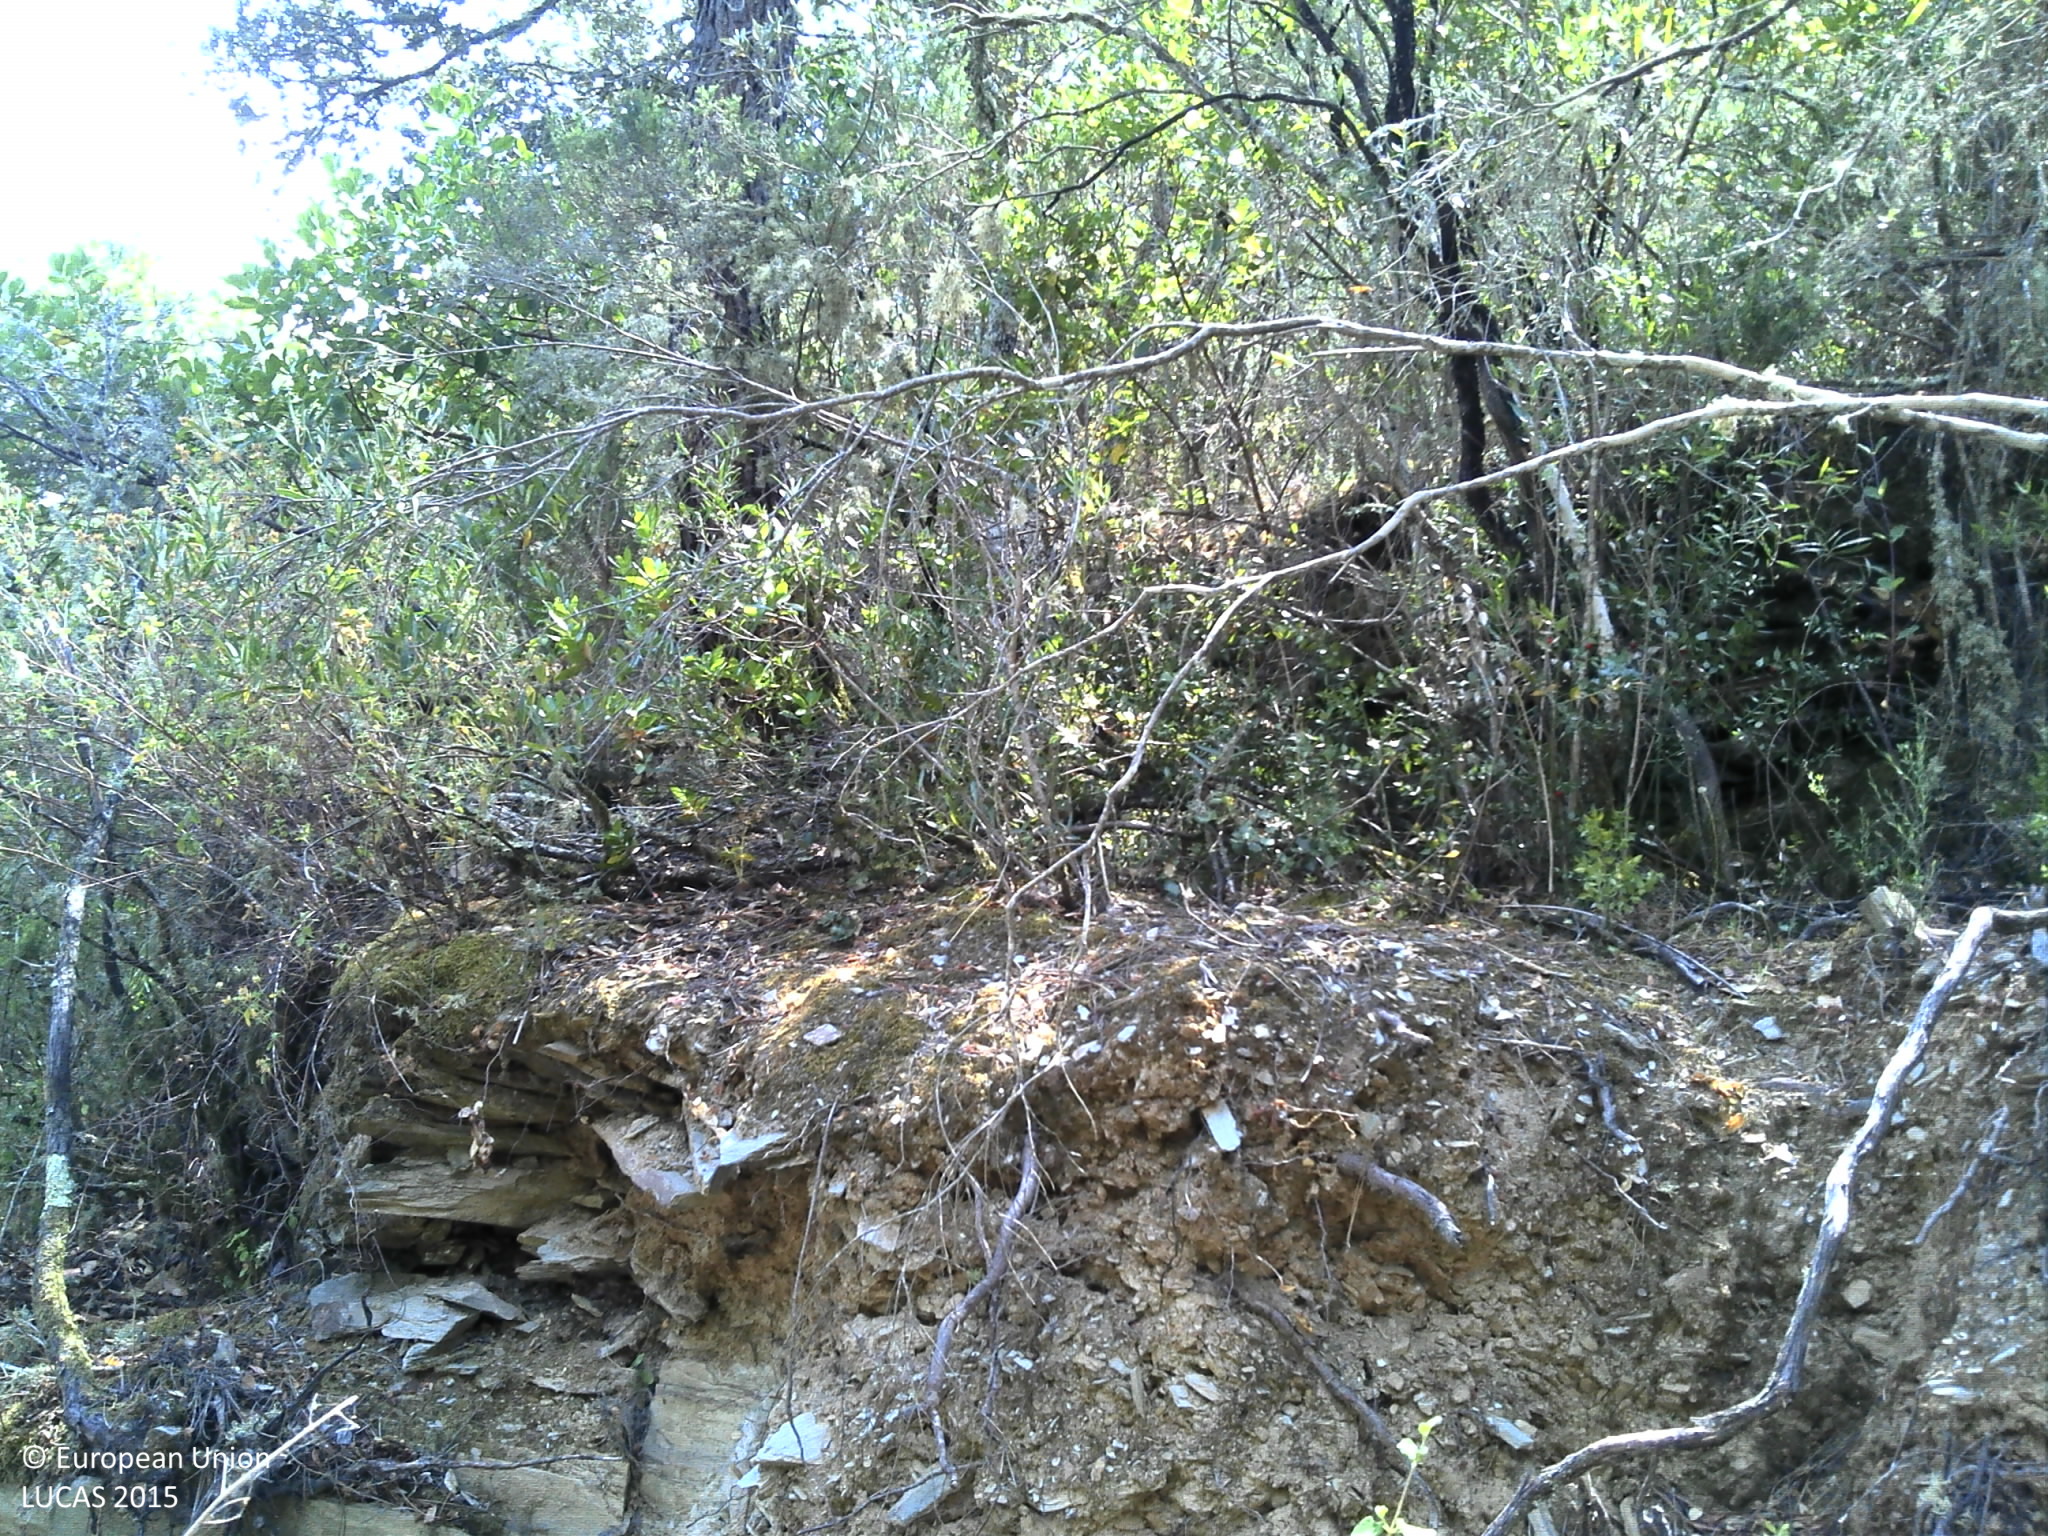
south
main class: Shrubland
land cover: Shrubland with sparse tree cover
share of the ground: > 75 %
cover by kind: shrubs 95 %, broadleaved forest trees 5 %
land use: Semi-natural and natural areas not in use
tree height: > 5 m
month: June
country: PT
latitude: 41.1746
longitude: -7.5871
